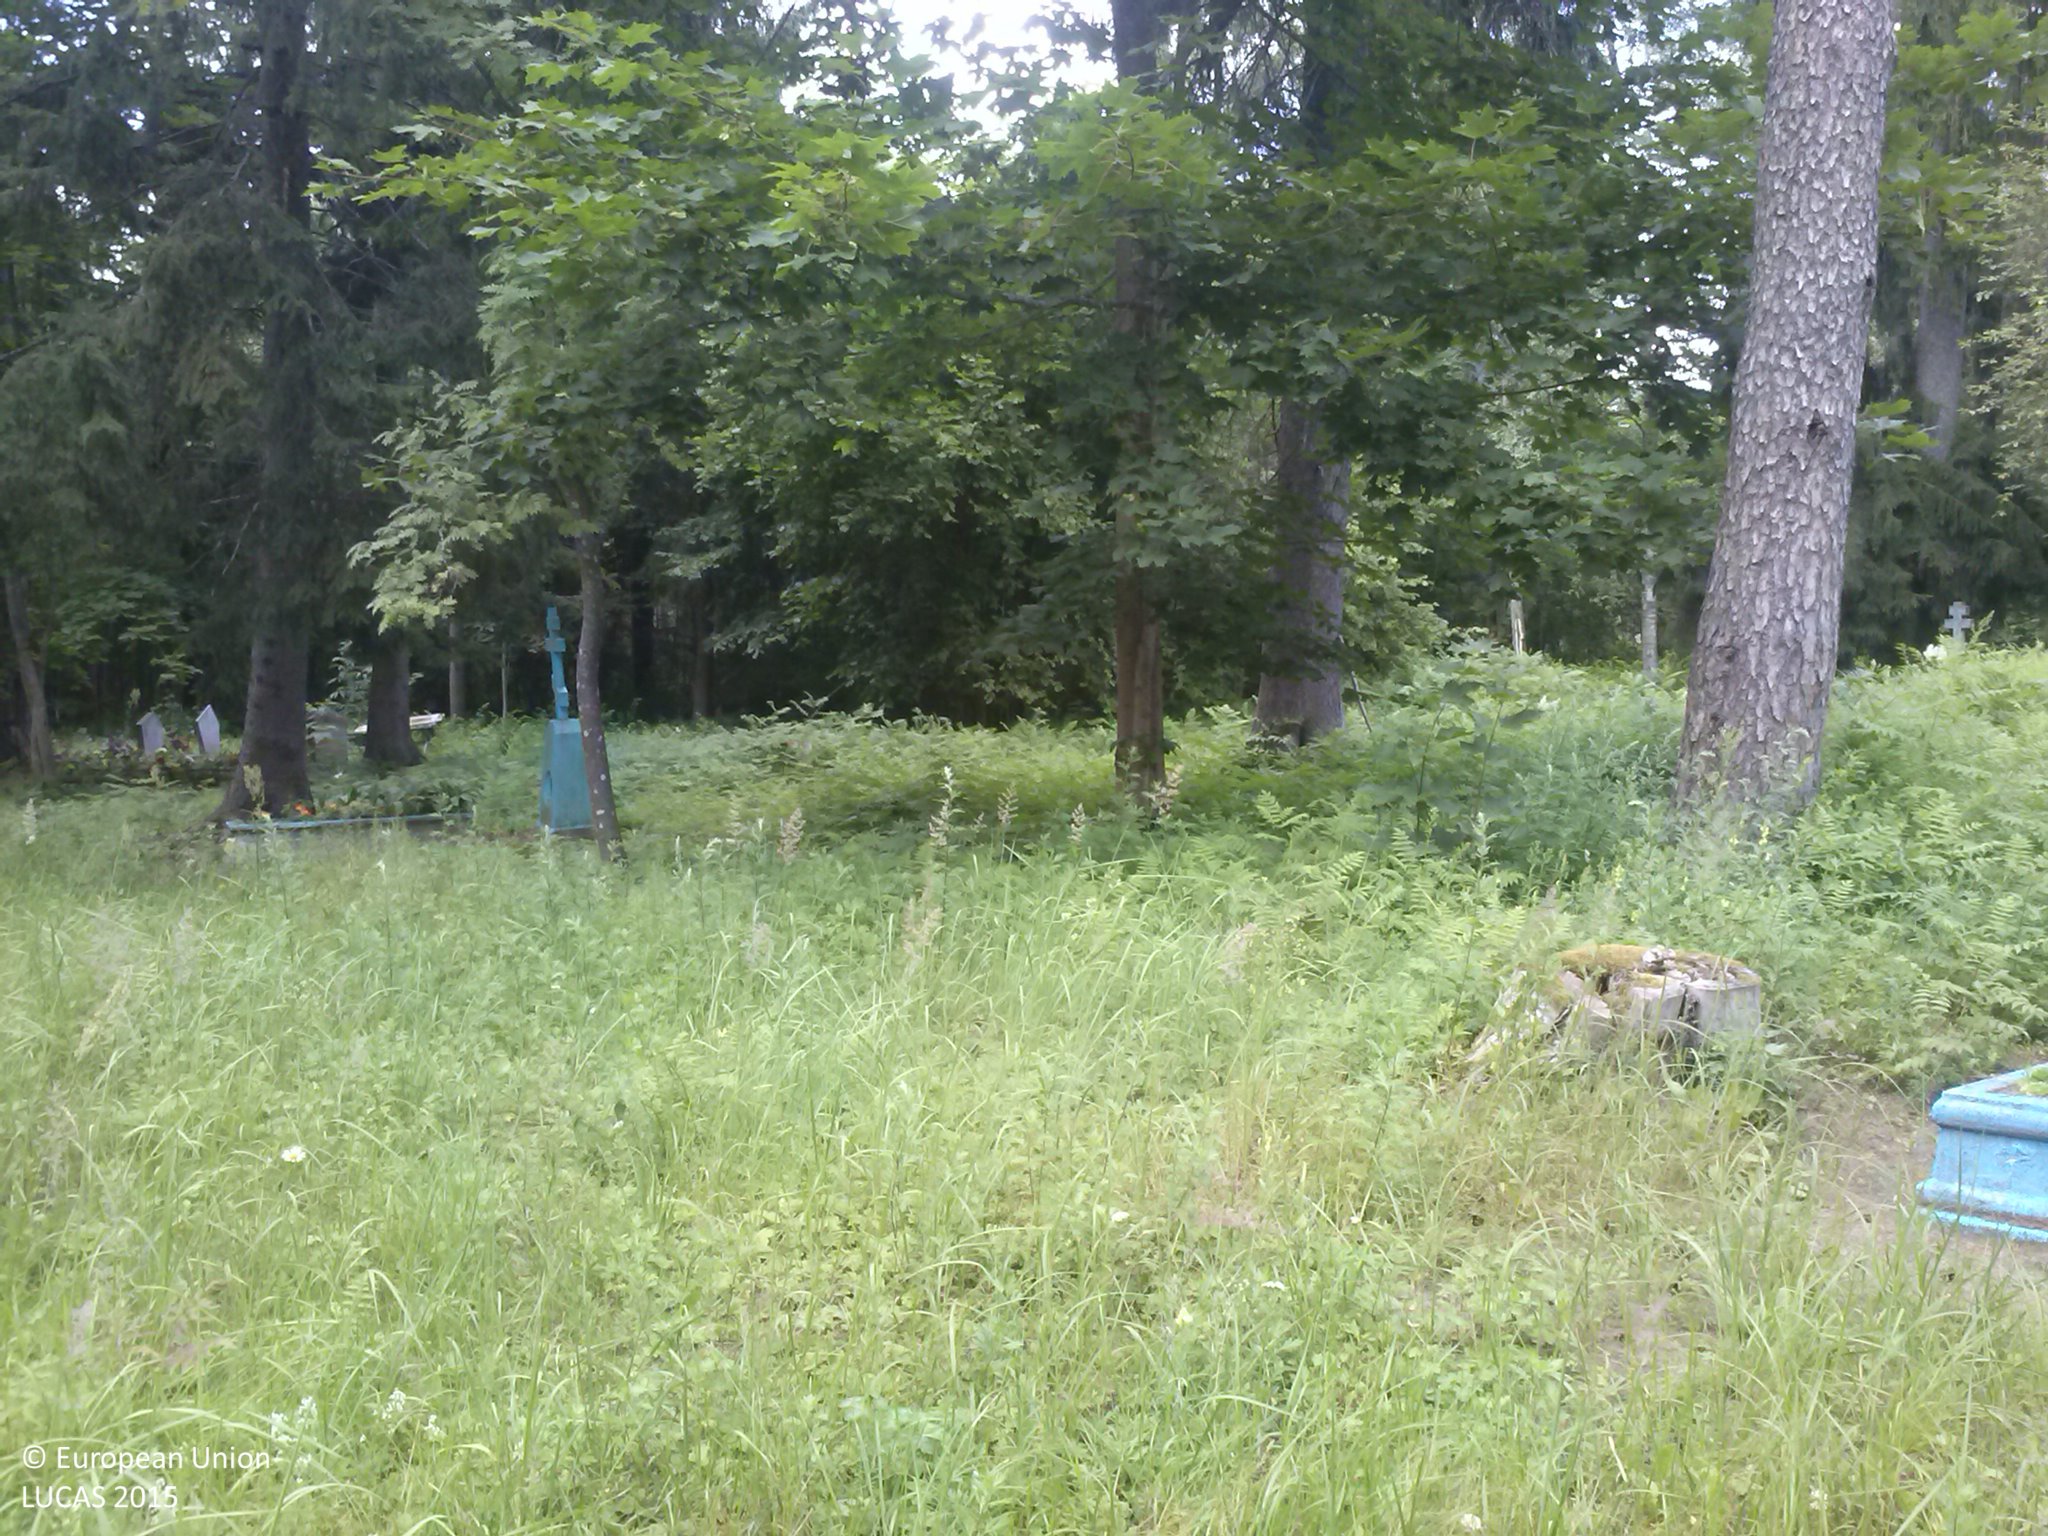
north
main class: Grassland
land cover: Grassland without tree/shrub cover
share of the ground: > 75 %
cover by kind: herbaceous plants 100 %
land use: Community services
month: July
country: LV
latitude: 56.5477
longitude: 27.0314
